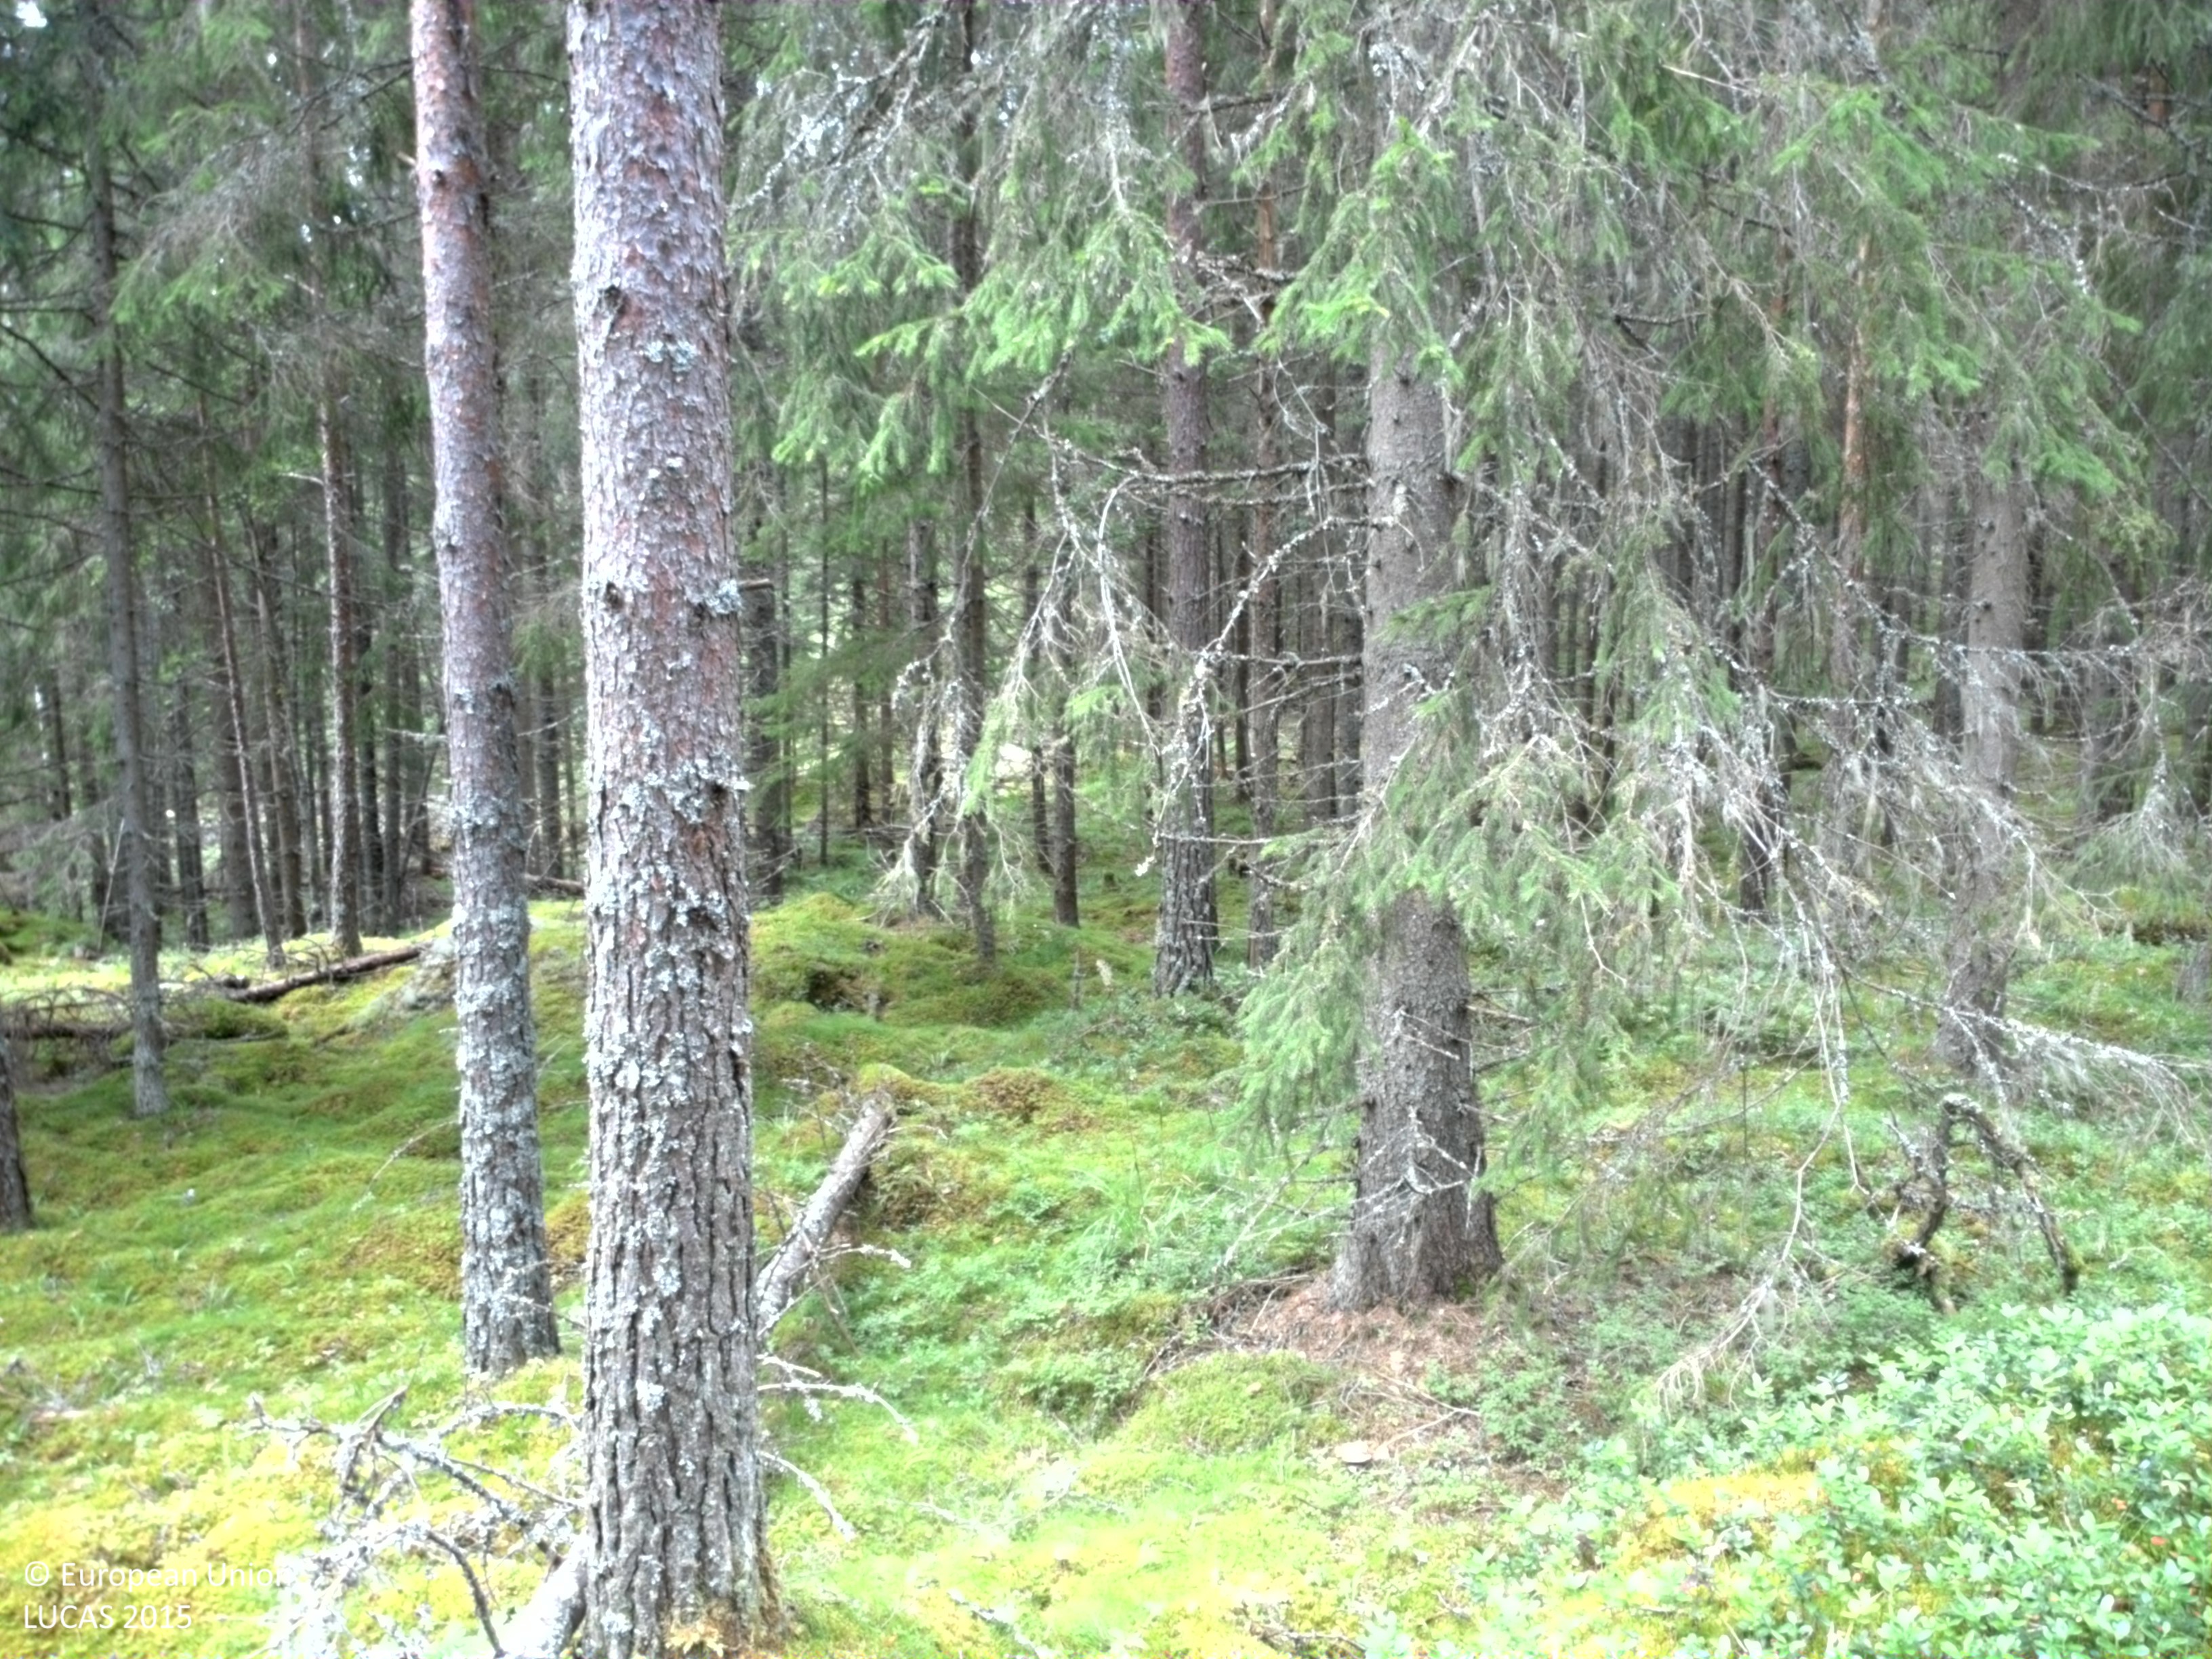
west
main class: Woodland
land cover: Pine dominated coniferous woodland
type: boreal forest
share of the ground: 50 - 75 %
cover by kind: coniferous forest trees 55 %, shrubs 20 %, lichens and mosses 20 %, broadleaved forest trees 5 %
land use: Forestry
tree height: > 5 m
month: July
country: SE
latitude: 59.4475
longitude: 11.9174
